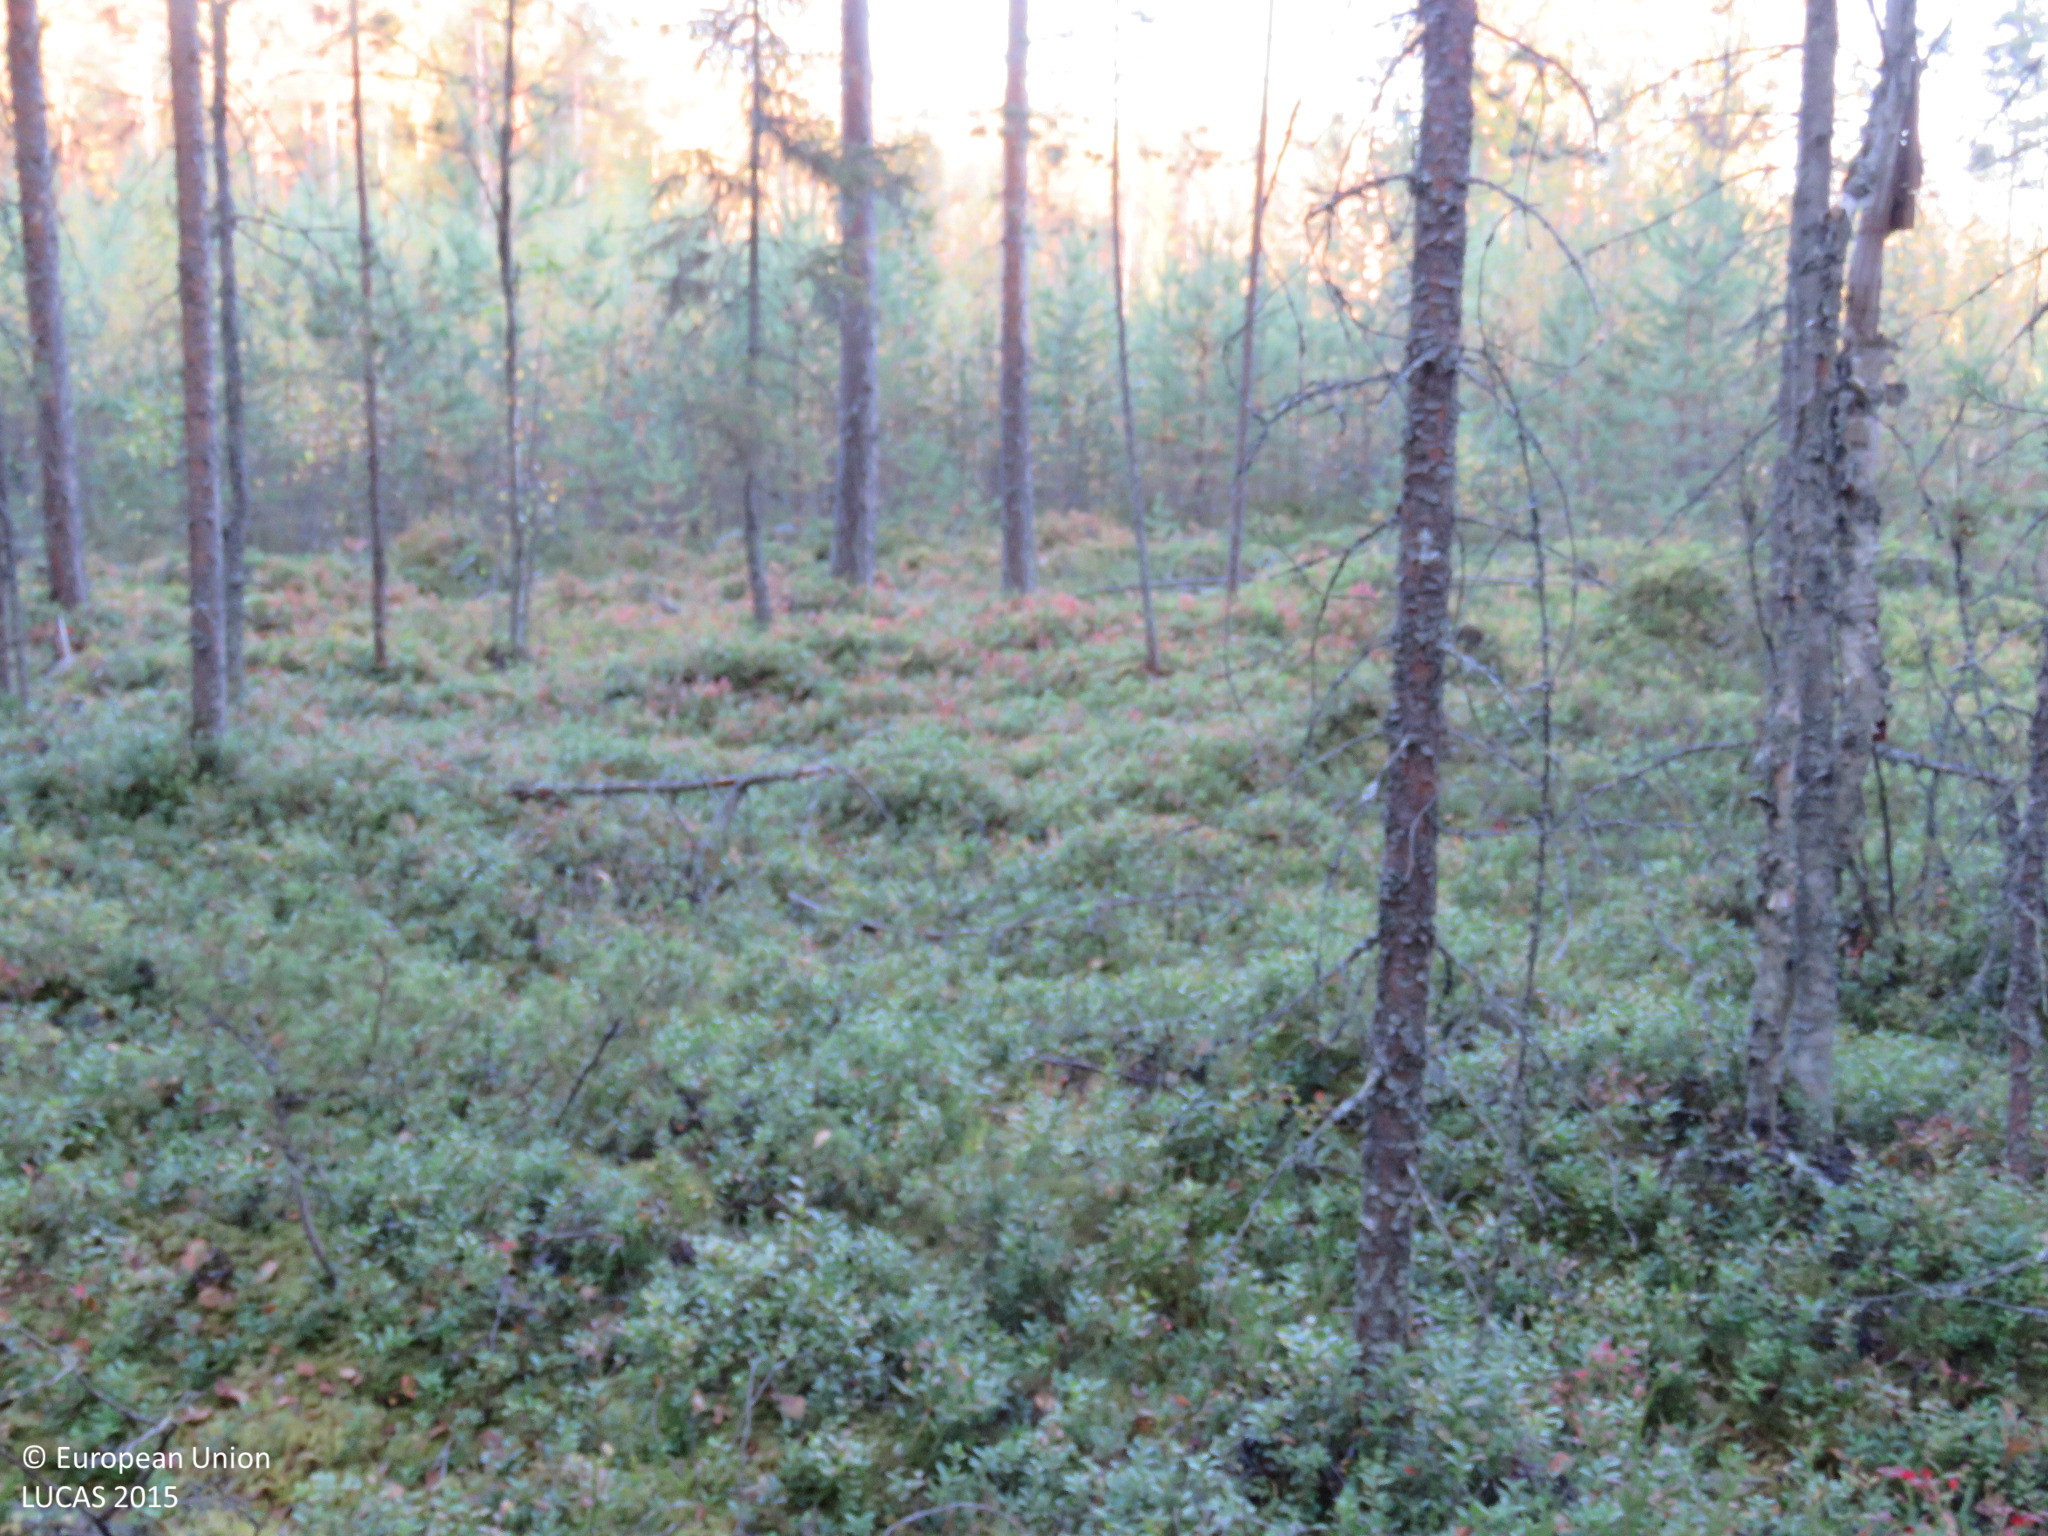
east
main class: Woodland
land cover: Other coniferous woodland
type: boreal forest
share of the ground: > 75 %
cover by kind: coniferous forest trees 70 %, shrubs 15 %, broadleaved forest trees 10 %, lichens and mosses 5 %
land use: Forestry
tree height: > 5 m
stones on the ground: < 10 %
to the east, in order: Other coniferous woodland; Pine dominated mixed woodland; Pine dominated coniferous woodland; Tracks; Pine dominated coniferous woodland
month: September
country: FI
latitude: 65.0389
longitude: 26.3940
